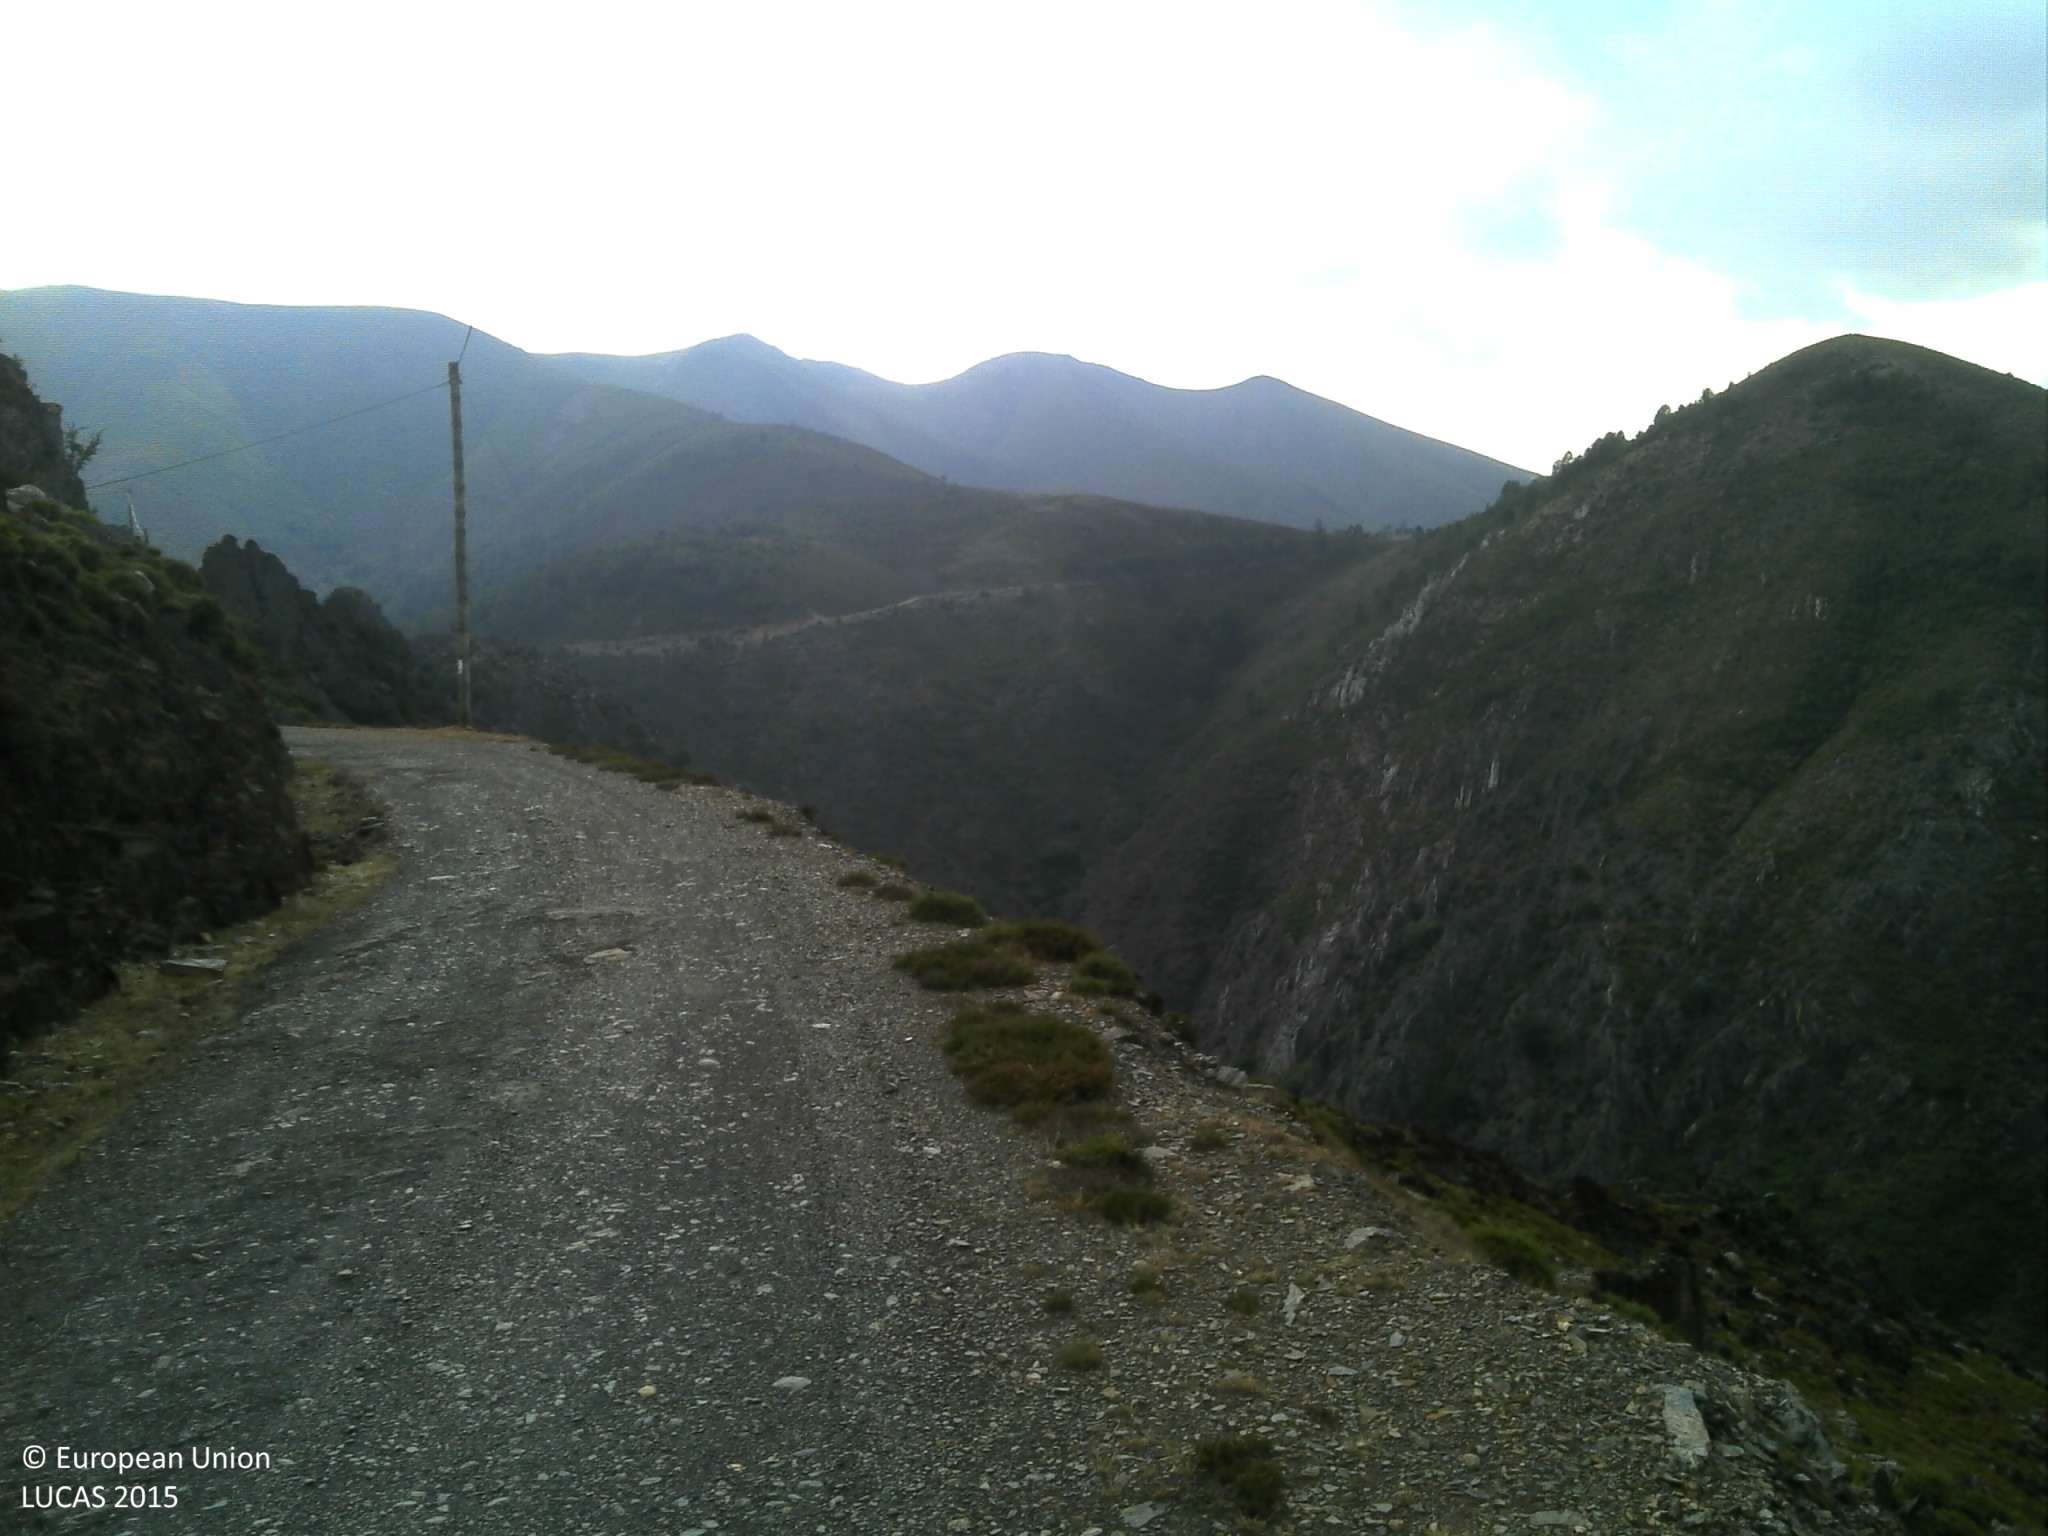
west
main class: Shrubland
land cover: Shrubland without tree cover
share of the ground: > 75 %
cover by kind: shrubs 80 %, consolidated bare surface 15 %, unconsolidated bare surface 5 %
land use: Semi-natural and natural areas not in use
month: June
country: PT
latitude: 40.8976
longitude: -8.0929
